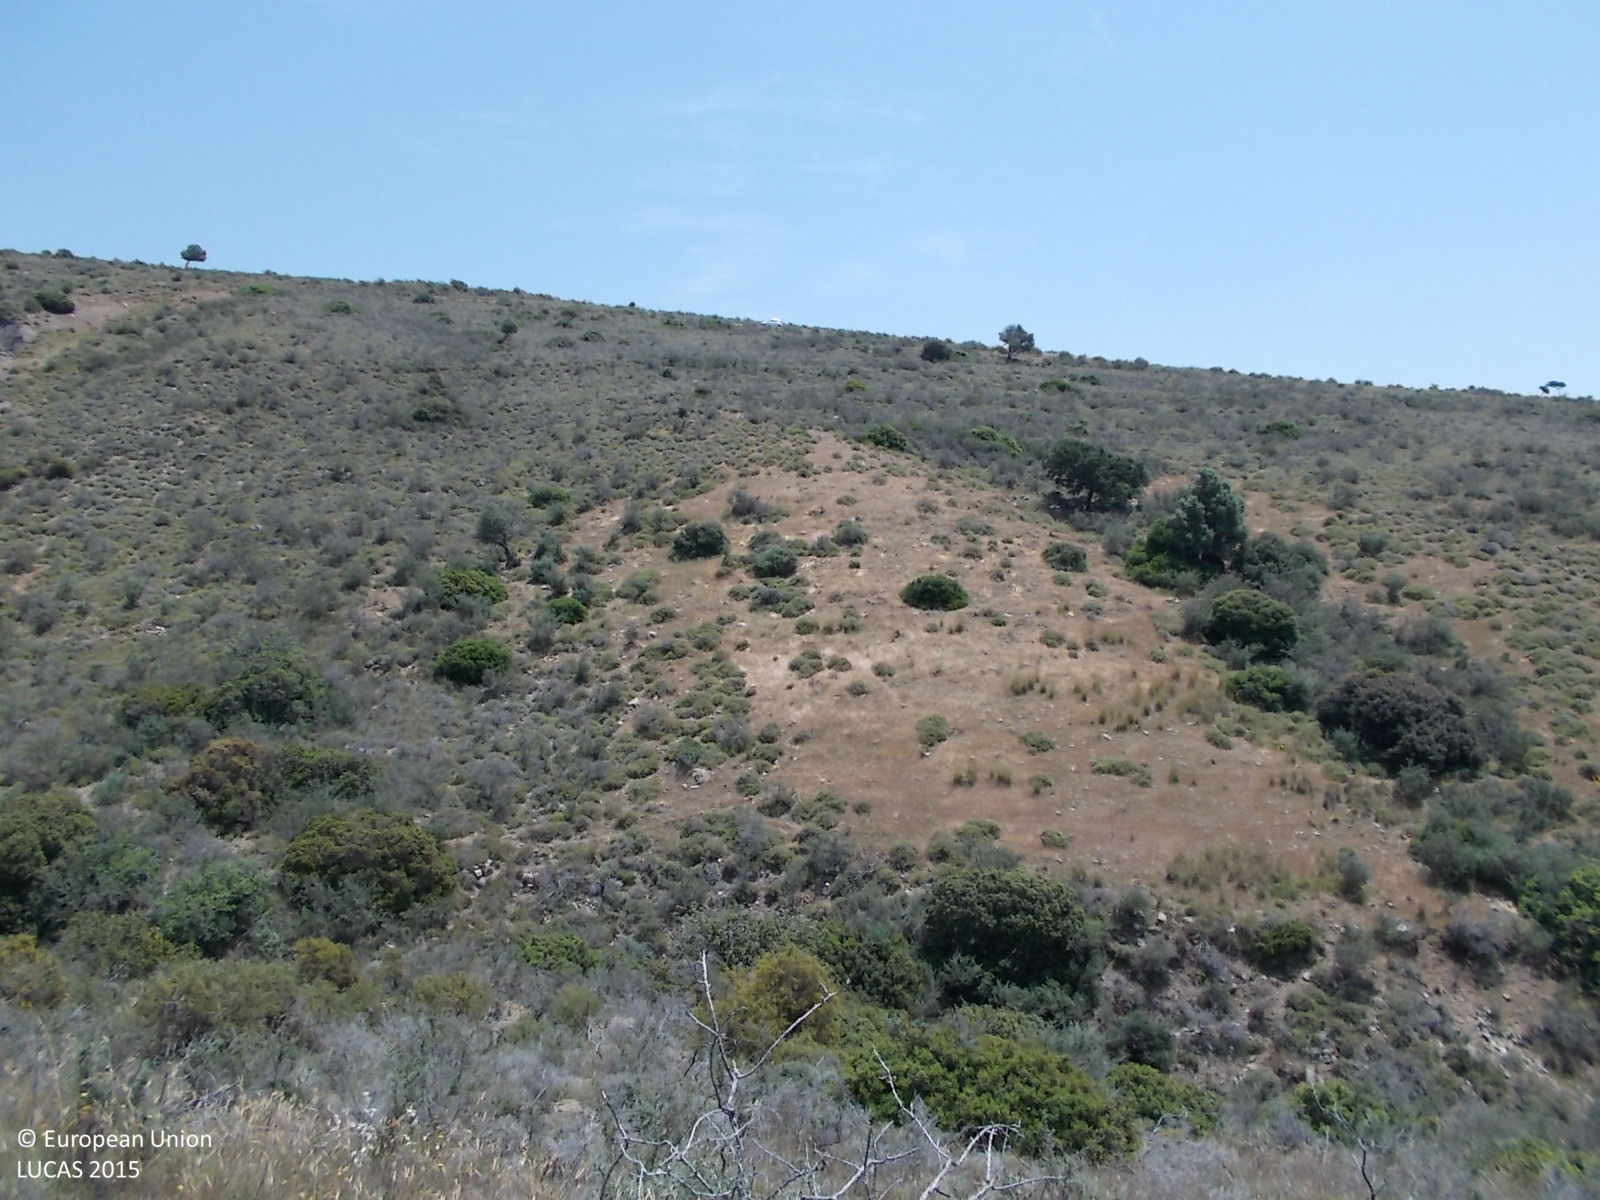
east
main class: Shrubland
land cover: Shrubland without tree cover
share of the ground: > 75 %
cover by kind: shrubs 90 %, unconsolidated bare surface 10 %
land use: Semi-natural and natural areas not in use
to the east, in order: Shrubland without tree cover; Inland fresh running water; Shrubland without tree cover; Grassland without tree/shrub cover; Shrubland without tree cover; Paved roads, cycling and walking lanes; Shrubland without tree cover
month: May
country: CY
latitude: 34.8908
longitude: 32.3930
